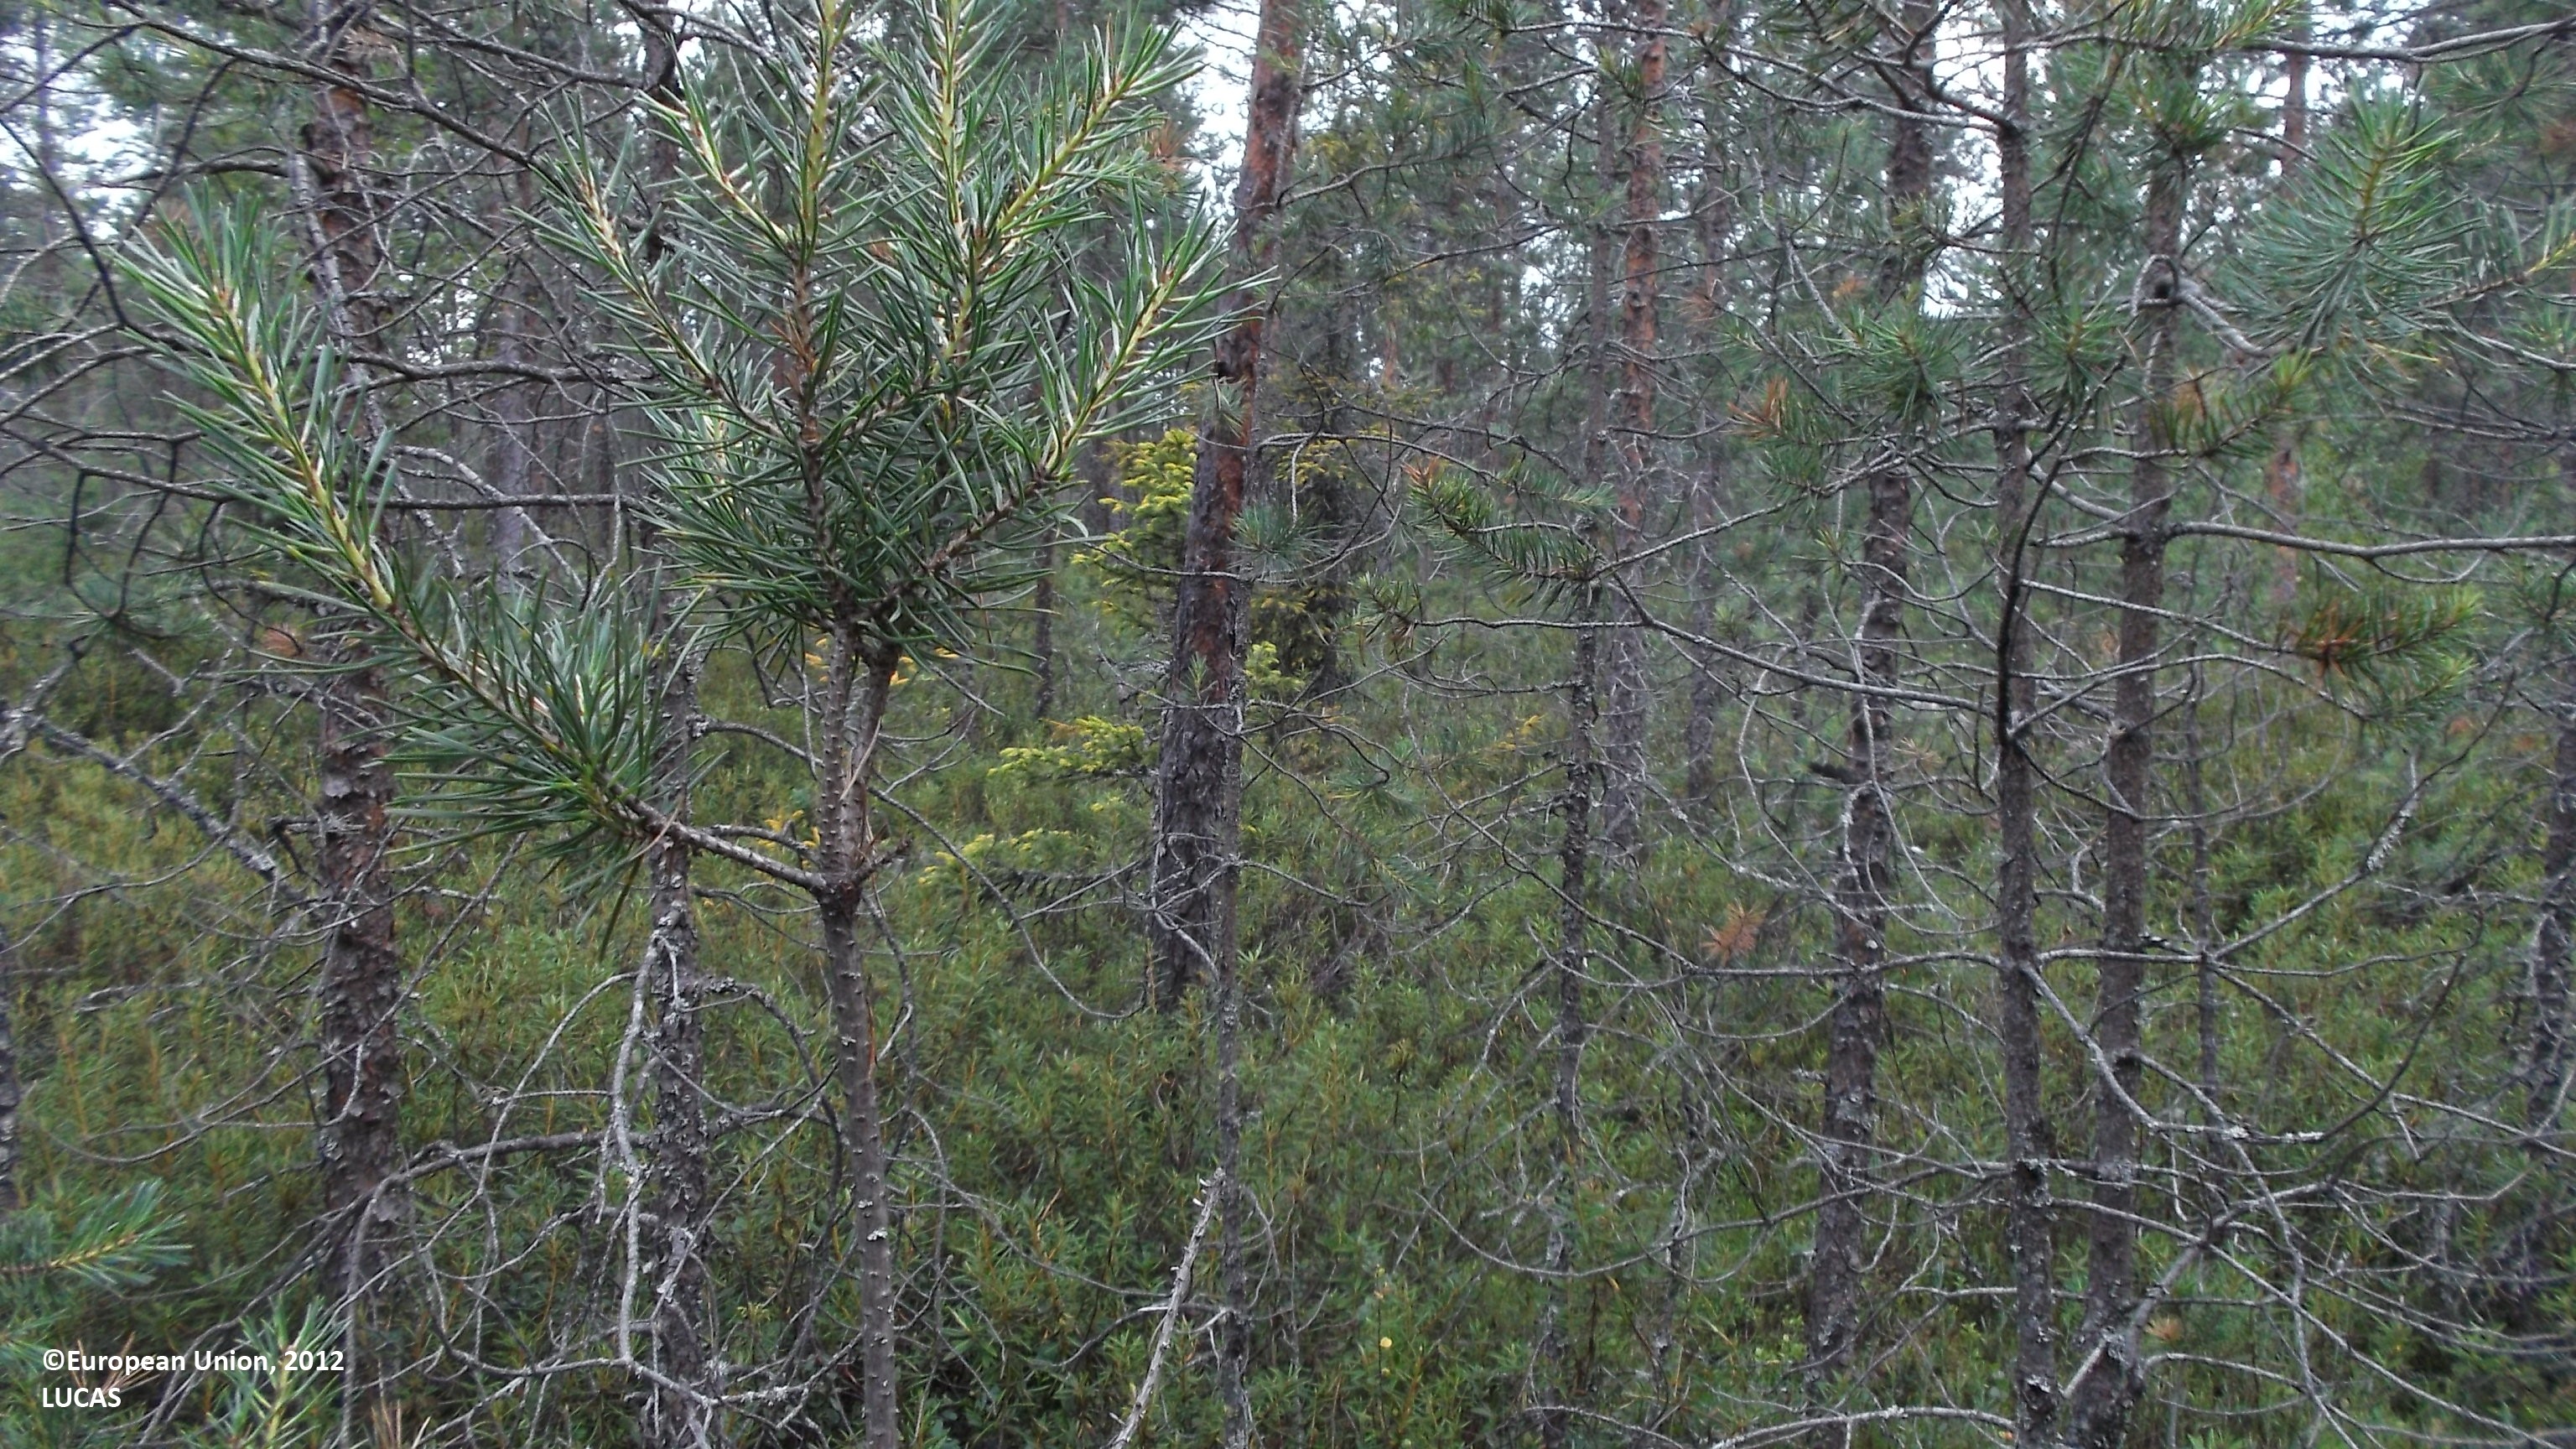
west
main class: Woodland
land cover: Pine dominated coniferous woodland
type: mire and swamp forests
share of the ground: 25 - 50 %
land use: Forestry
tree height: < 5 m
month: July
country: FI
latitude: 63.5470
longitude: 23.2365
